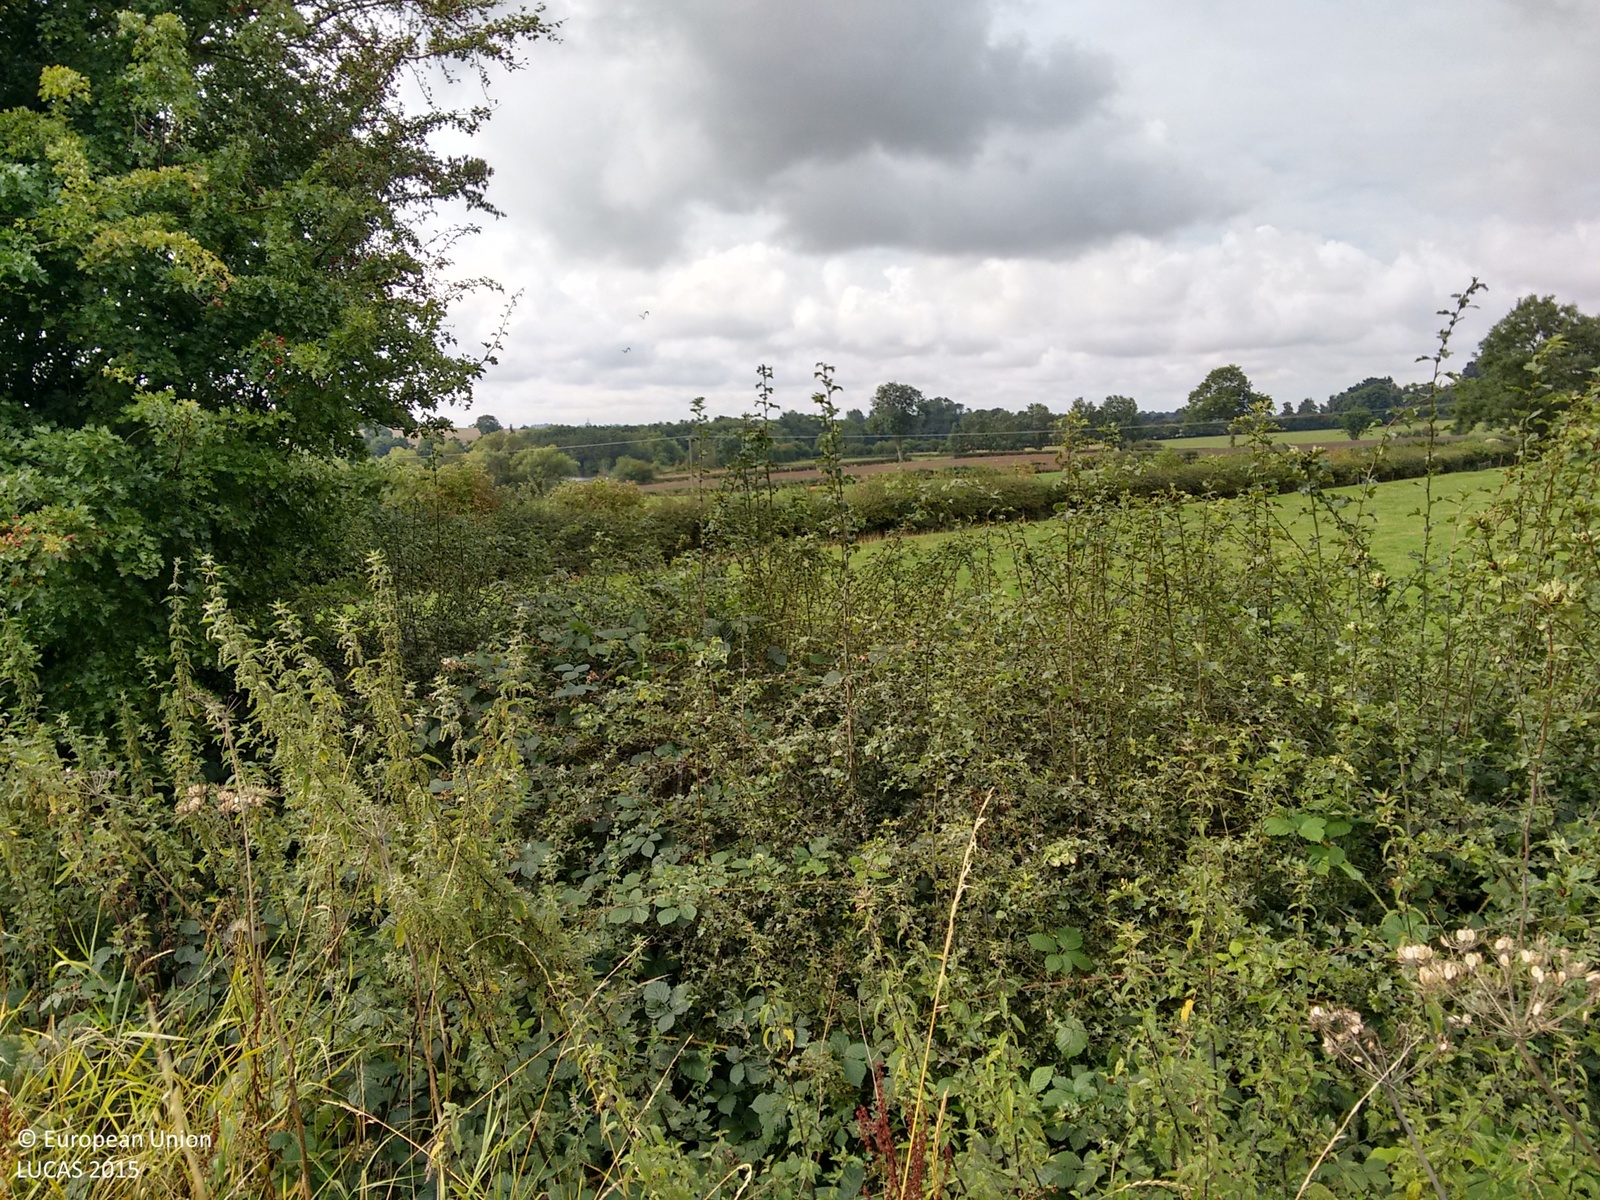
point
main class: Grassland
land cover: Grassland without tree/shrub cover
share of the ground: > 75 %
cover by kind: herbaceous plants 100 %
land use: Agriculture (excluding fallow land and kitchen gardens)
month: September
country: GB
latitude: 52.7223
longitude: -1.5255
